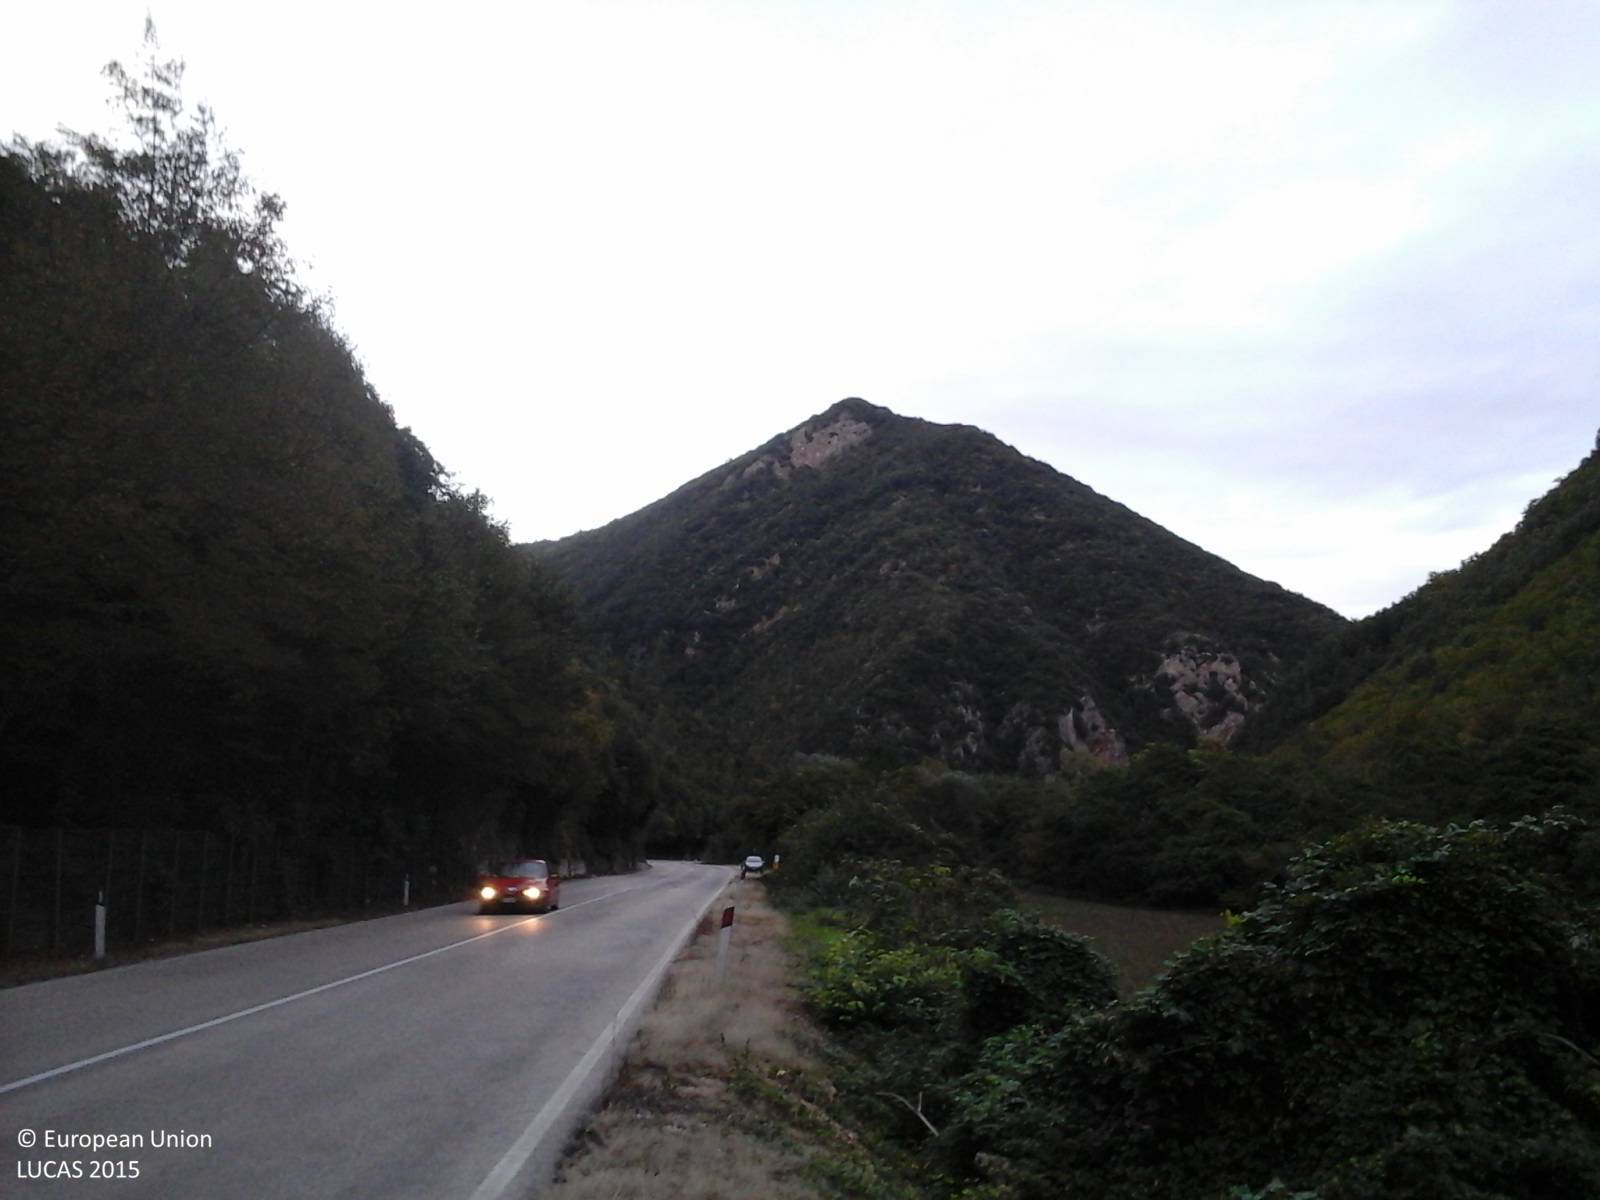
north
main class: Woodland
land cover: Broadleaved woodland
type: thermophilous deciduous forest
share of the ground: > 75 %
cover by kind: broadleaved forest trees 90 %, shrubs 10 %
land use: Forestry
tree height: > 5 m
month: October
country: IT
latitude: 42.7935
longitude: 12.8888
